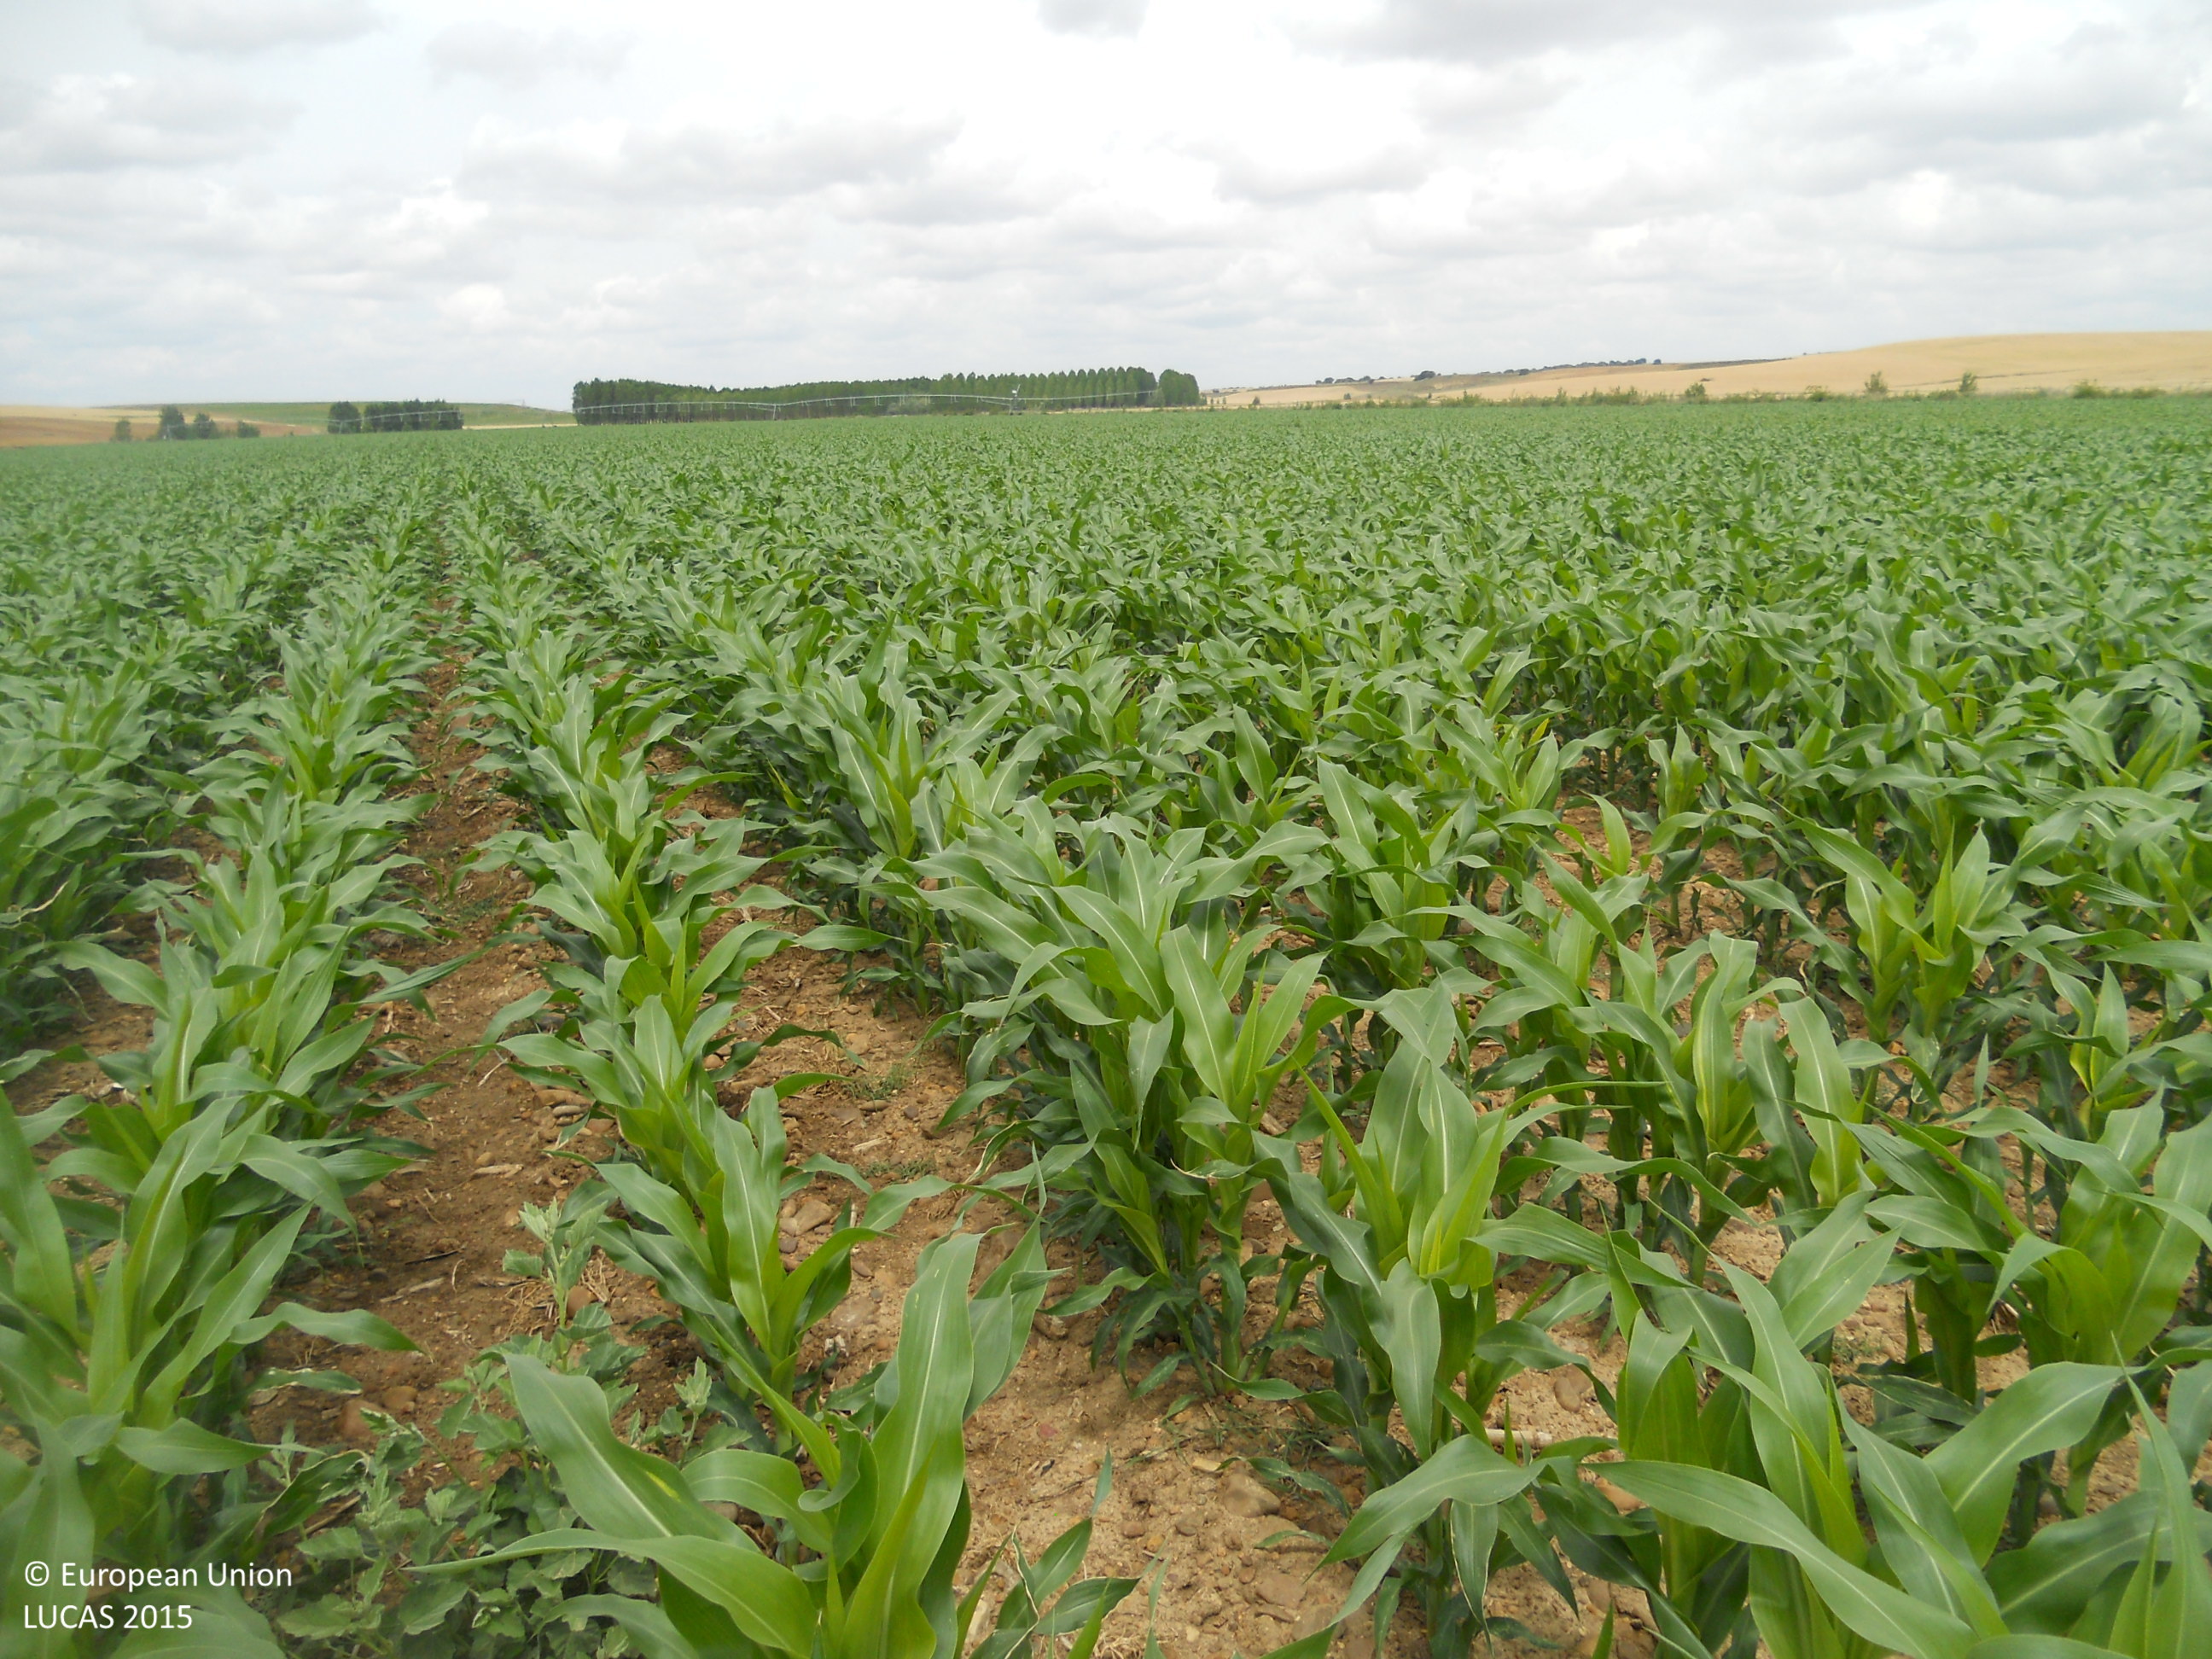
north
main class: Cropland
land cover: Maize
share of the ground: > 75 %
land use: Agriculture (excluding fallow land and kitchen gardens)
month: June
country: ES
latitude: 42.2969
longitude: -5.2610
